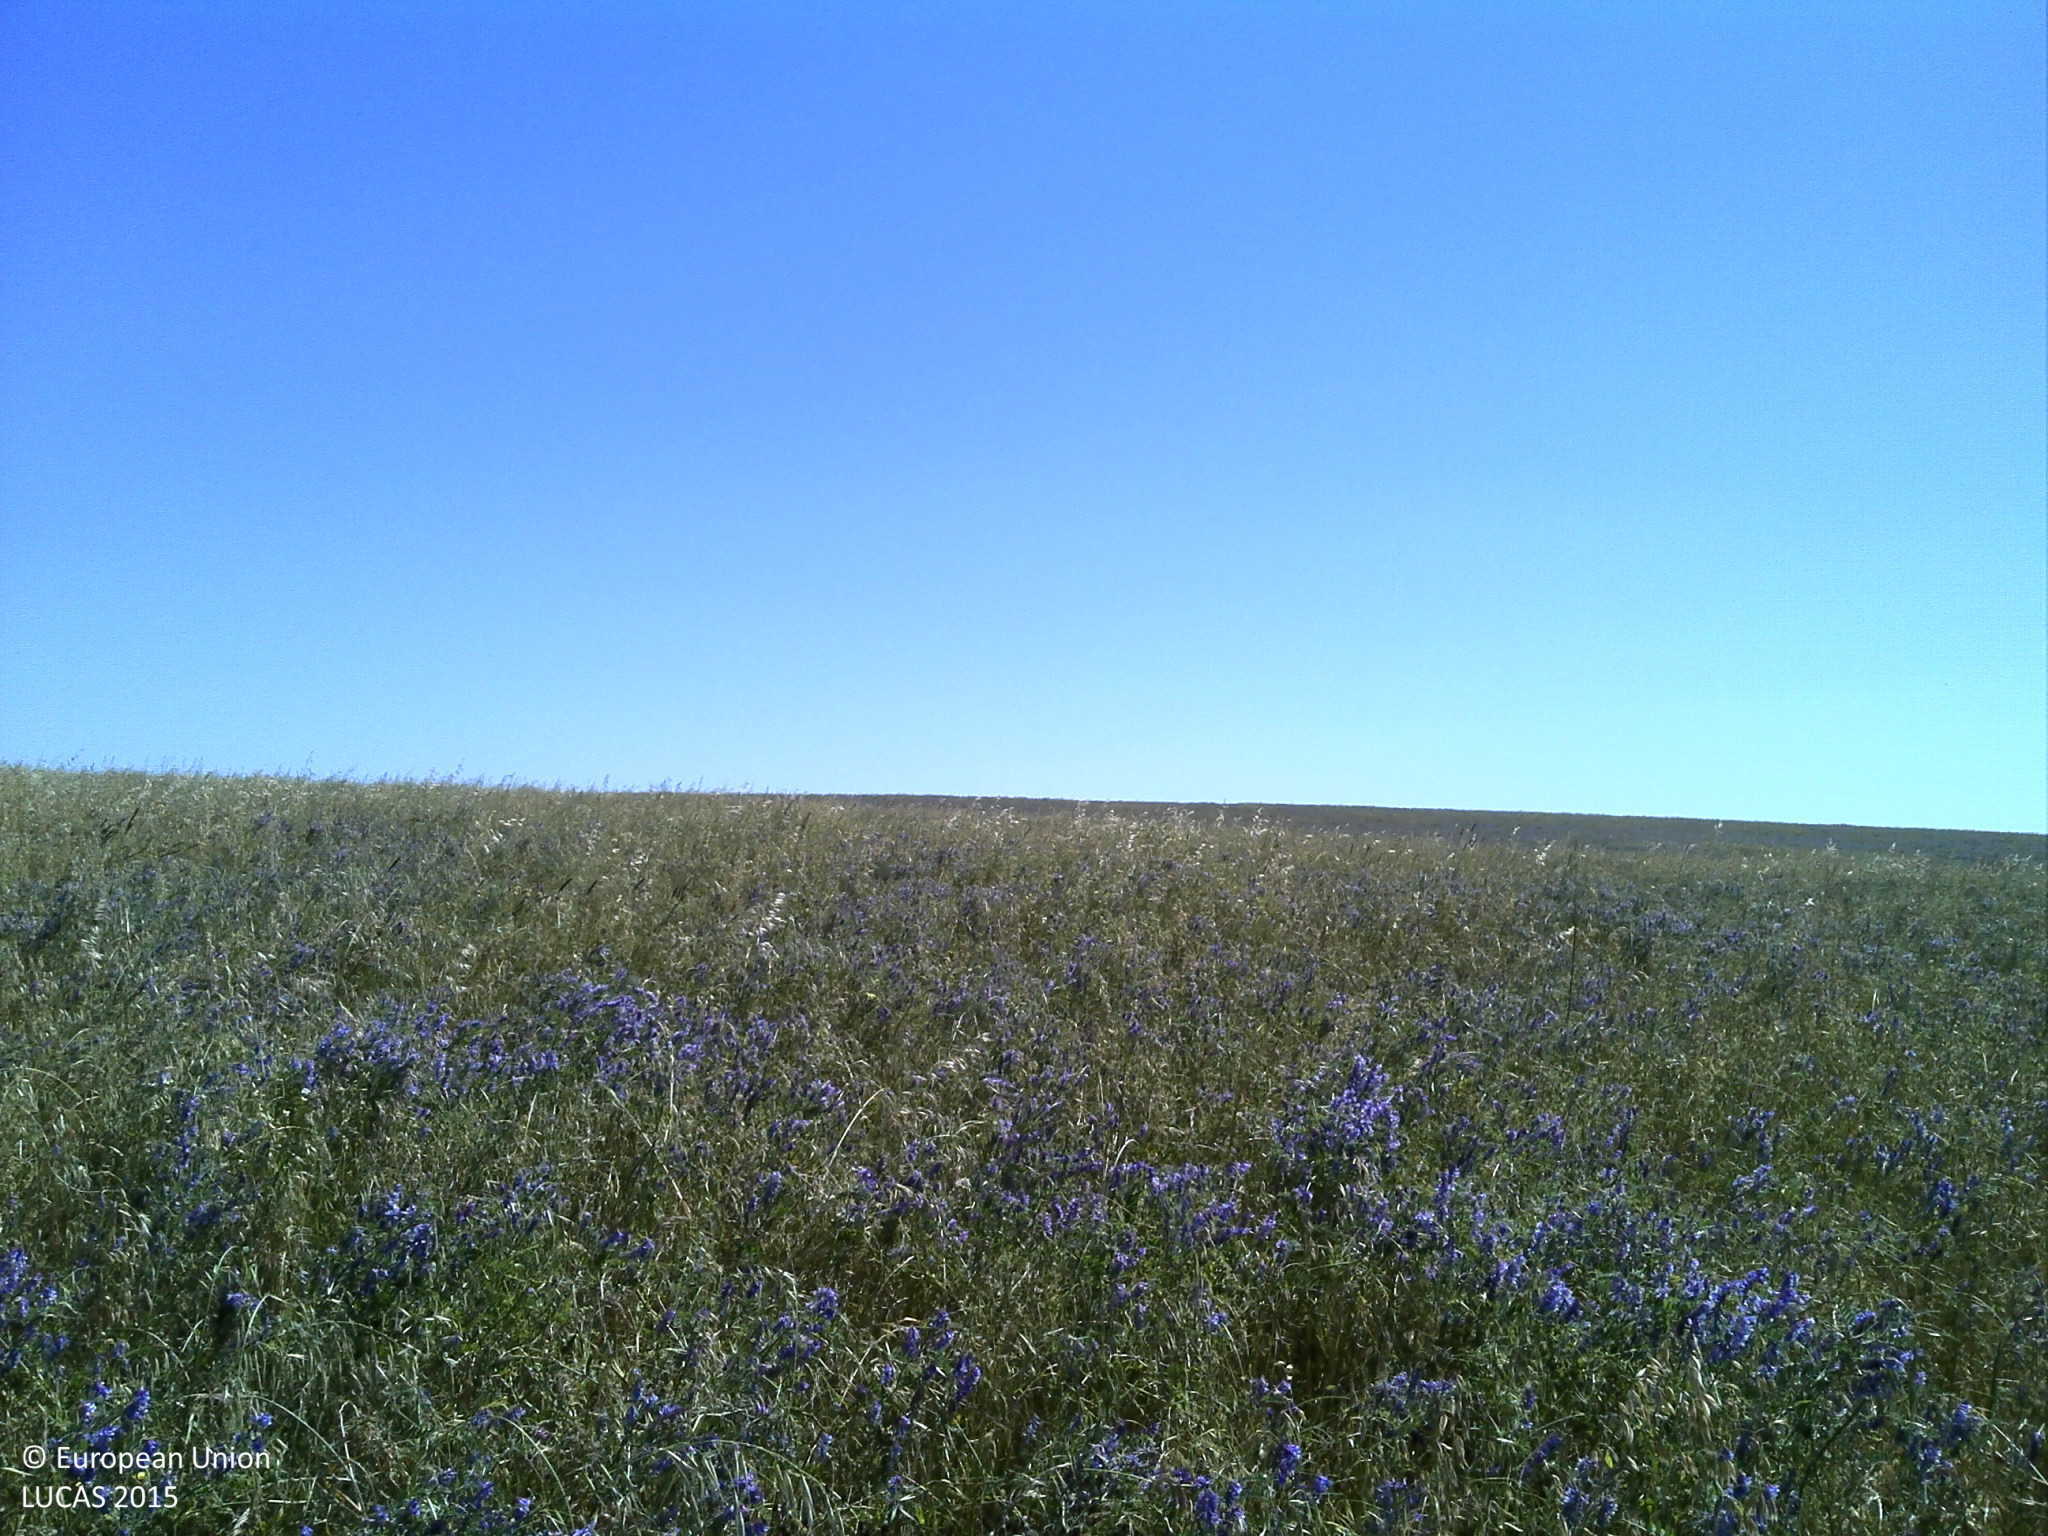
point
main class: Cropland
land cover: Temporary grasslands
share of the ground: > 75 %
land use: Agriculture (excluding fallow land and kitchen gardens)
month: May
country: PT
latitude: 39.1717
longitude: -7.8394
